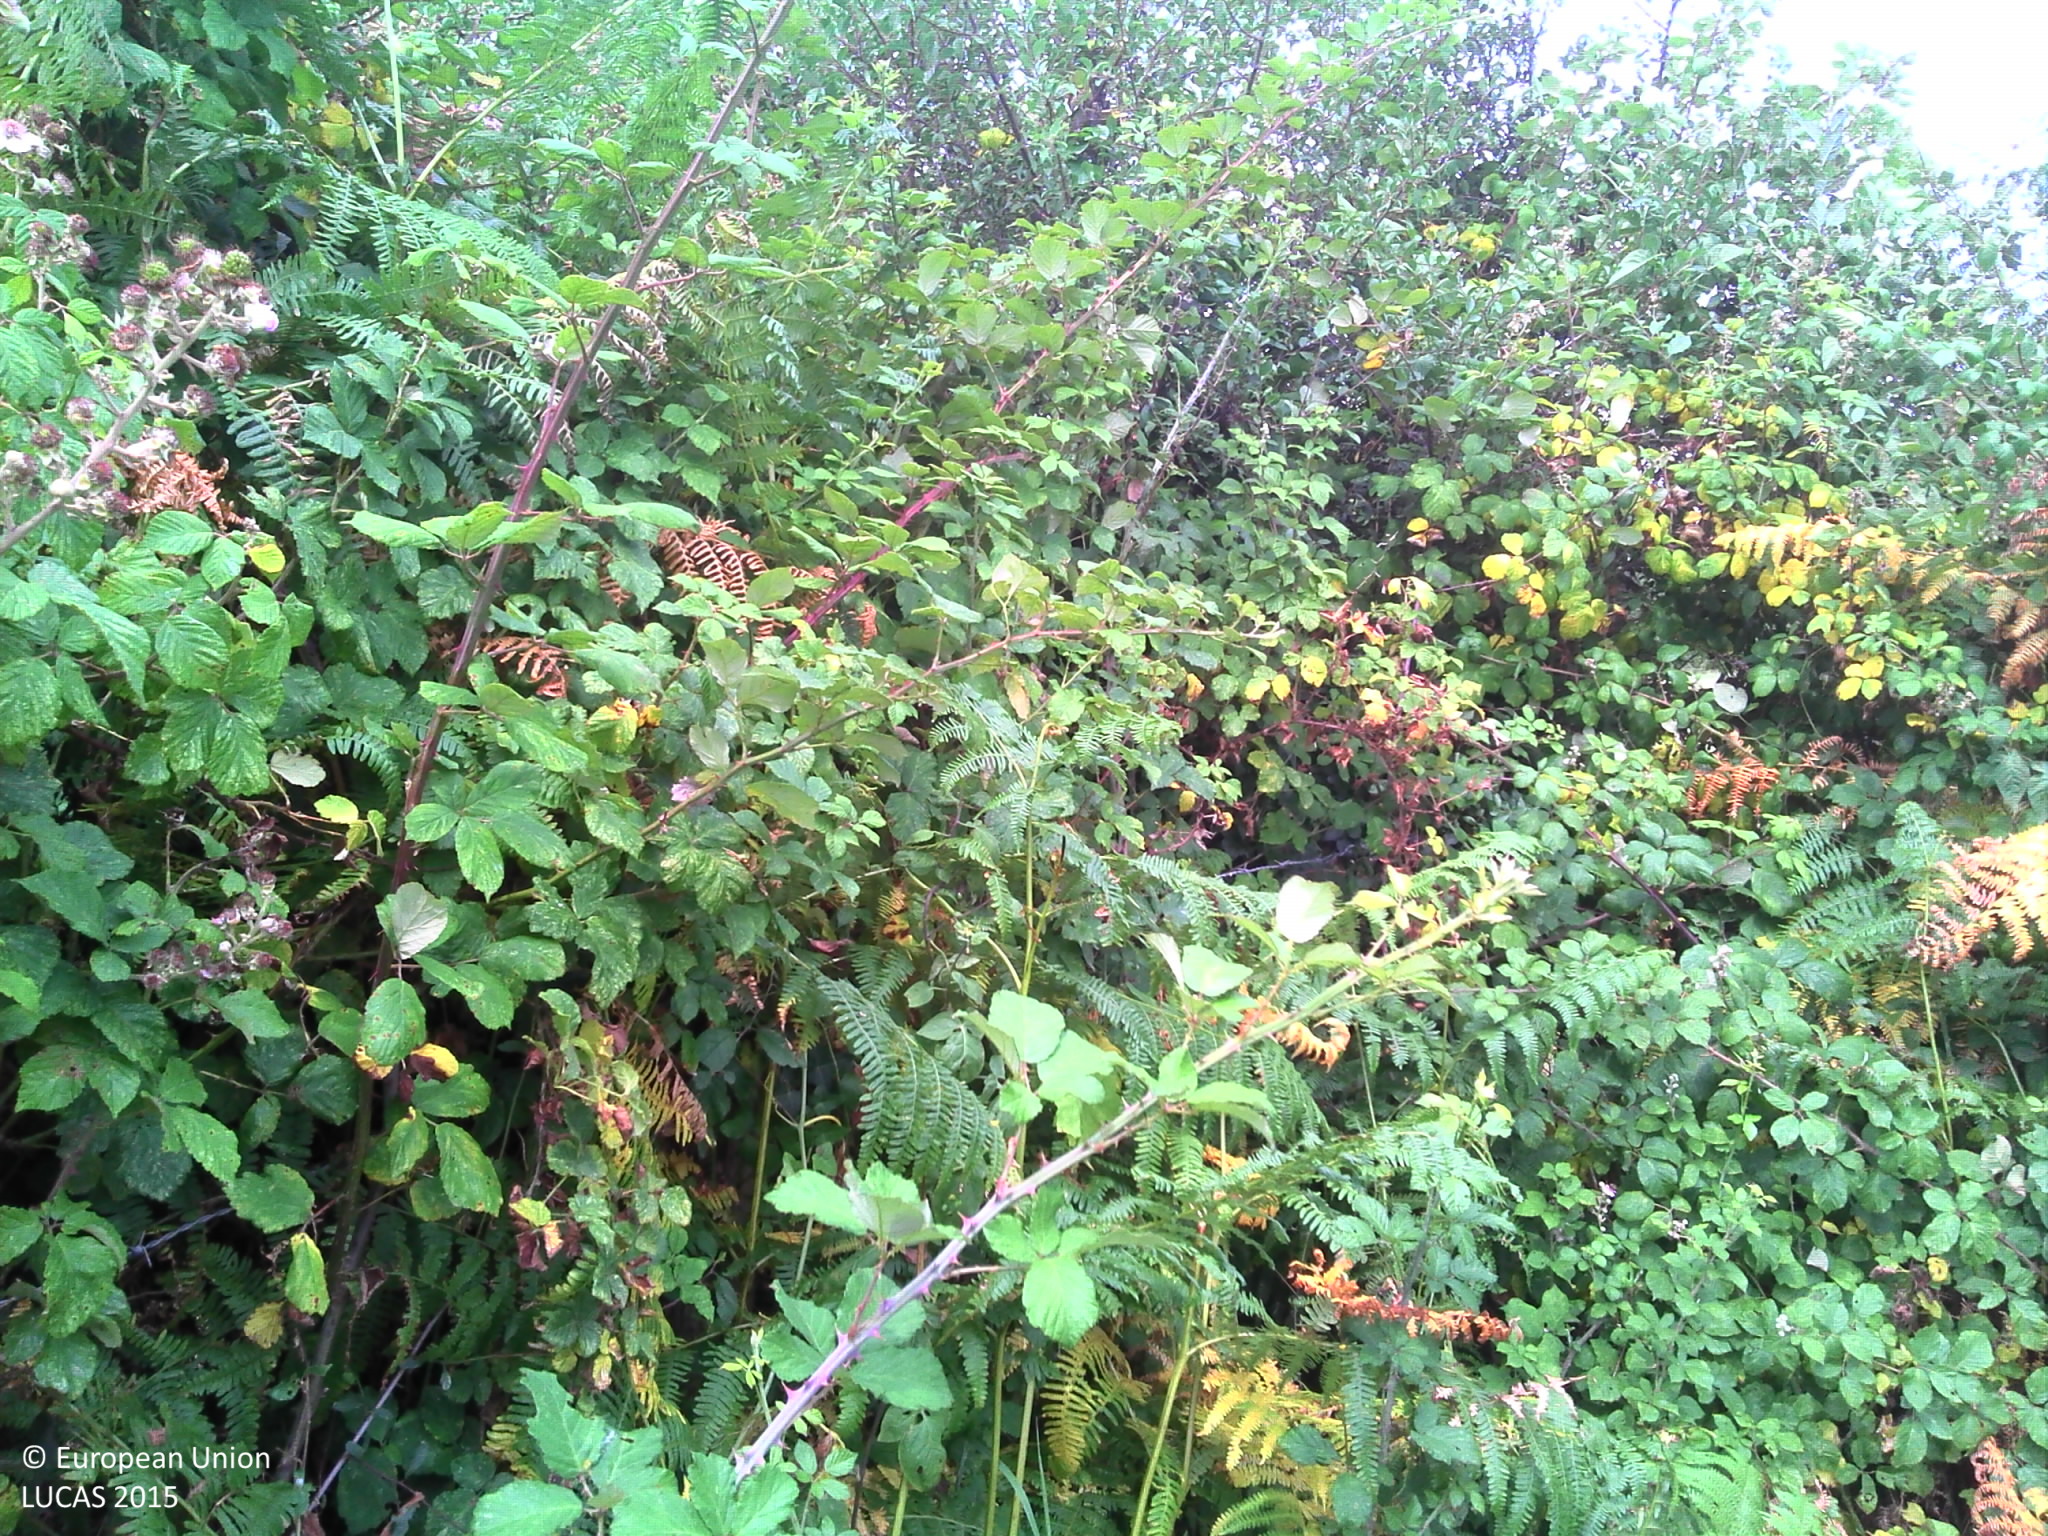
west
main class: Grassland
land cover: Grassland with sparse tree/shrub cover
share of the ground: > 75 %
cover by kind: herbaceous plants 95 %, broadleaved forest trees 5 %
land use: Agriculture (excluding fallow land and kitchen gardens)
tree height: > 5 m
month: July
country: FR
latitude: 47.2663
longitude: -1.7417
